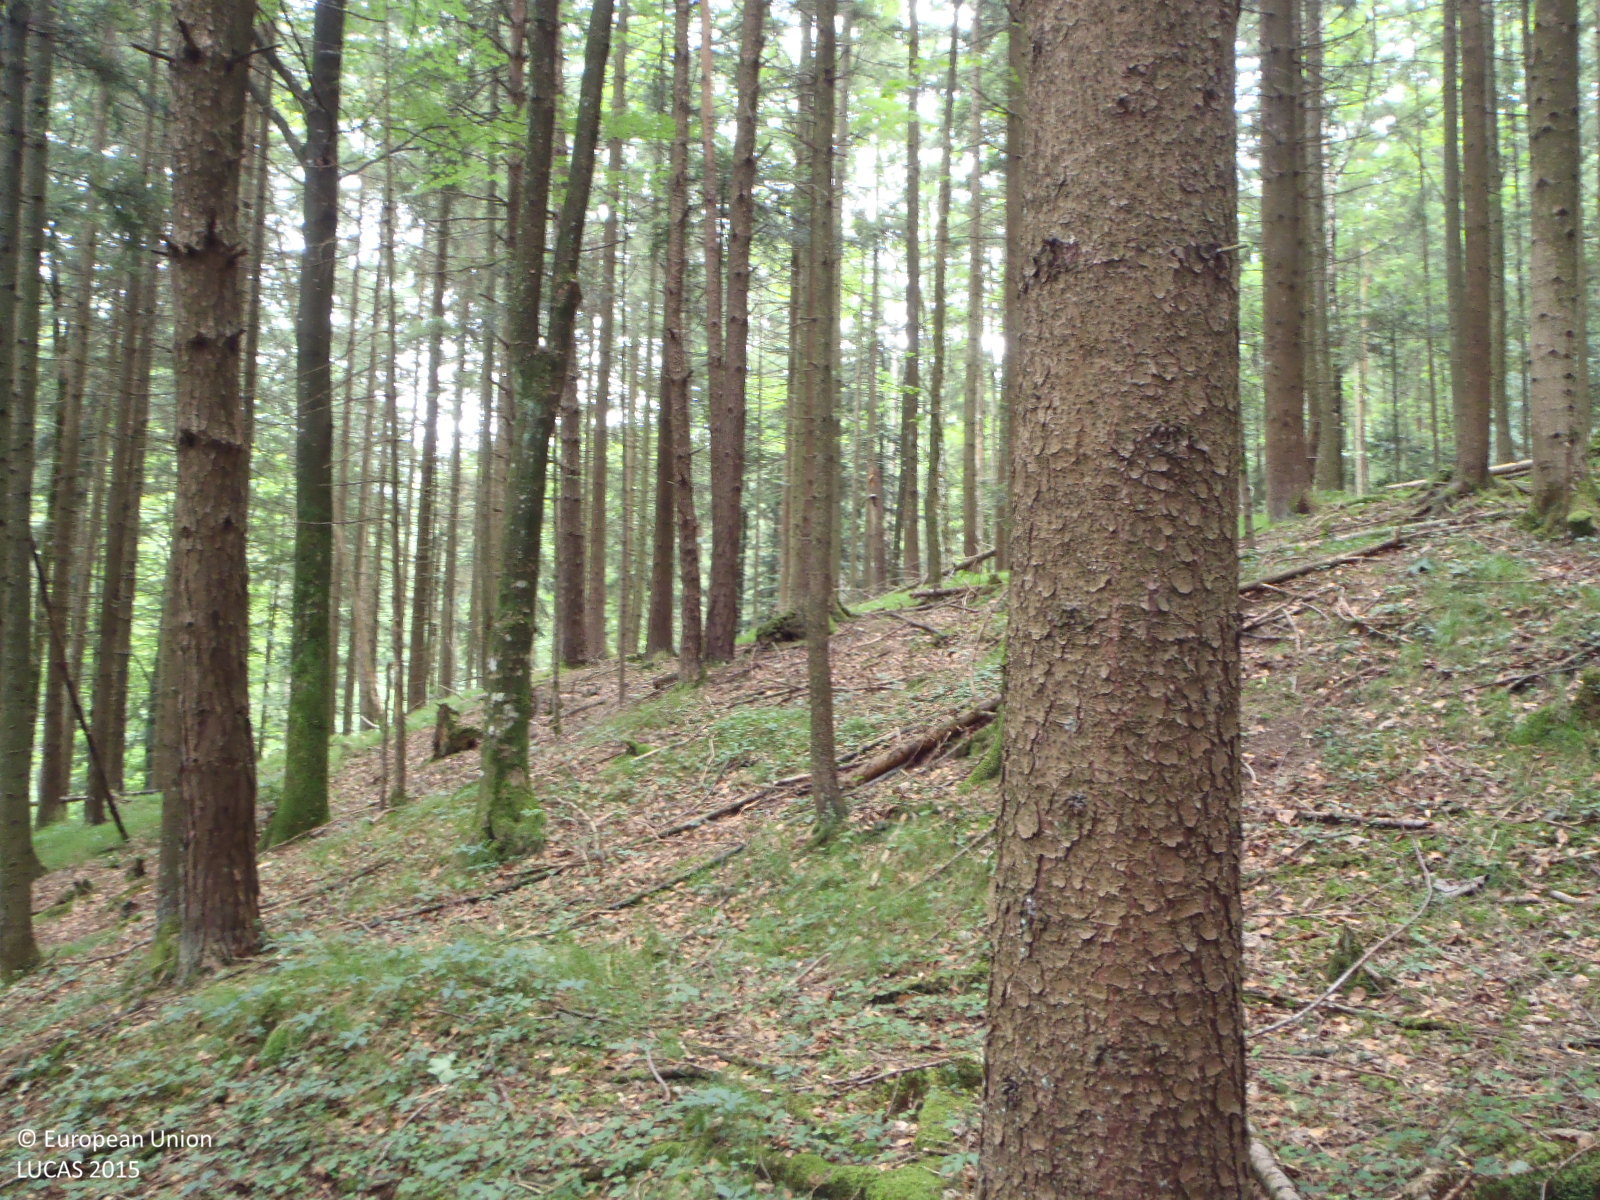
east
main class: Woodland
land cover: Spruce dominated coniferous woodland
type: alpine coniferous forest
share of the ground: > 75 %
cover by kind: coniferous forest trees 80 %, broadleaved forest trees 10 %, herbaceous plants 10 %
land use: Forestry
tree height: > 5 m
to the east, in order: Spruce dominated coniferous woodland; Other mixed woodland; Tracks; Other coniferous woodland; Paved roads, cycling and walking lanes; Other coniferous woodland
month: July
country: AT
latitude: 47.5896
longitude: 12.1926
